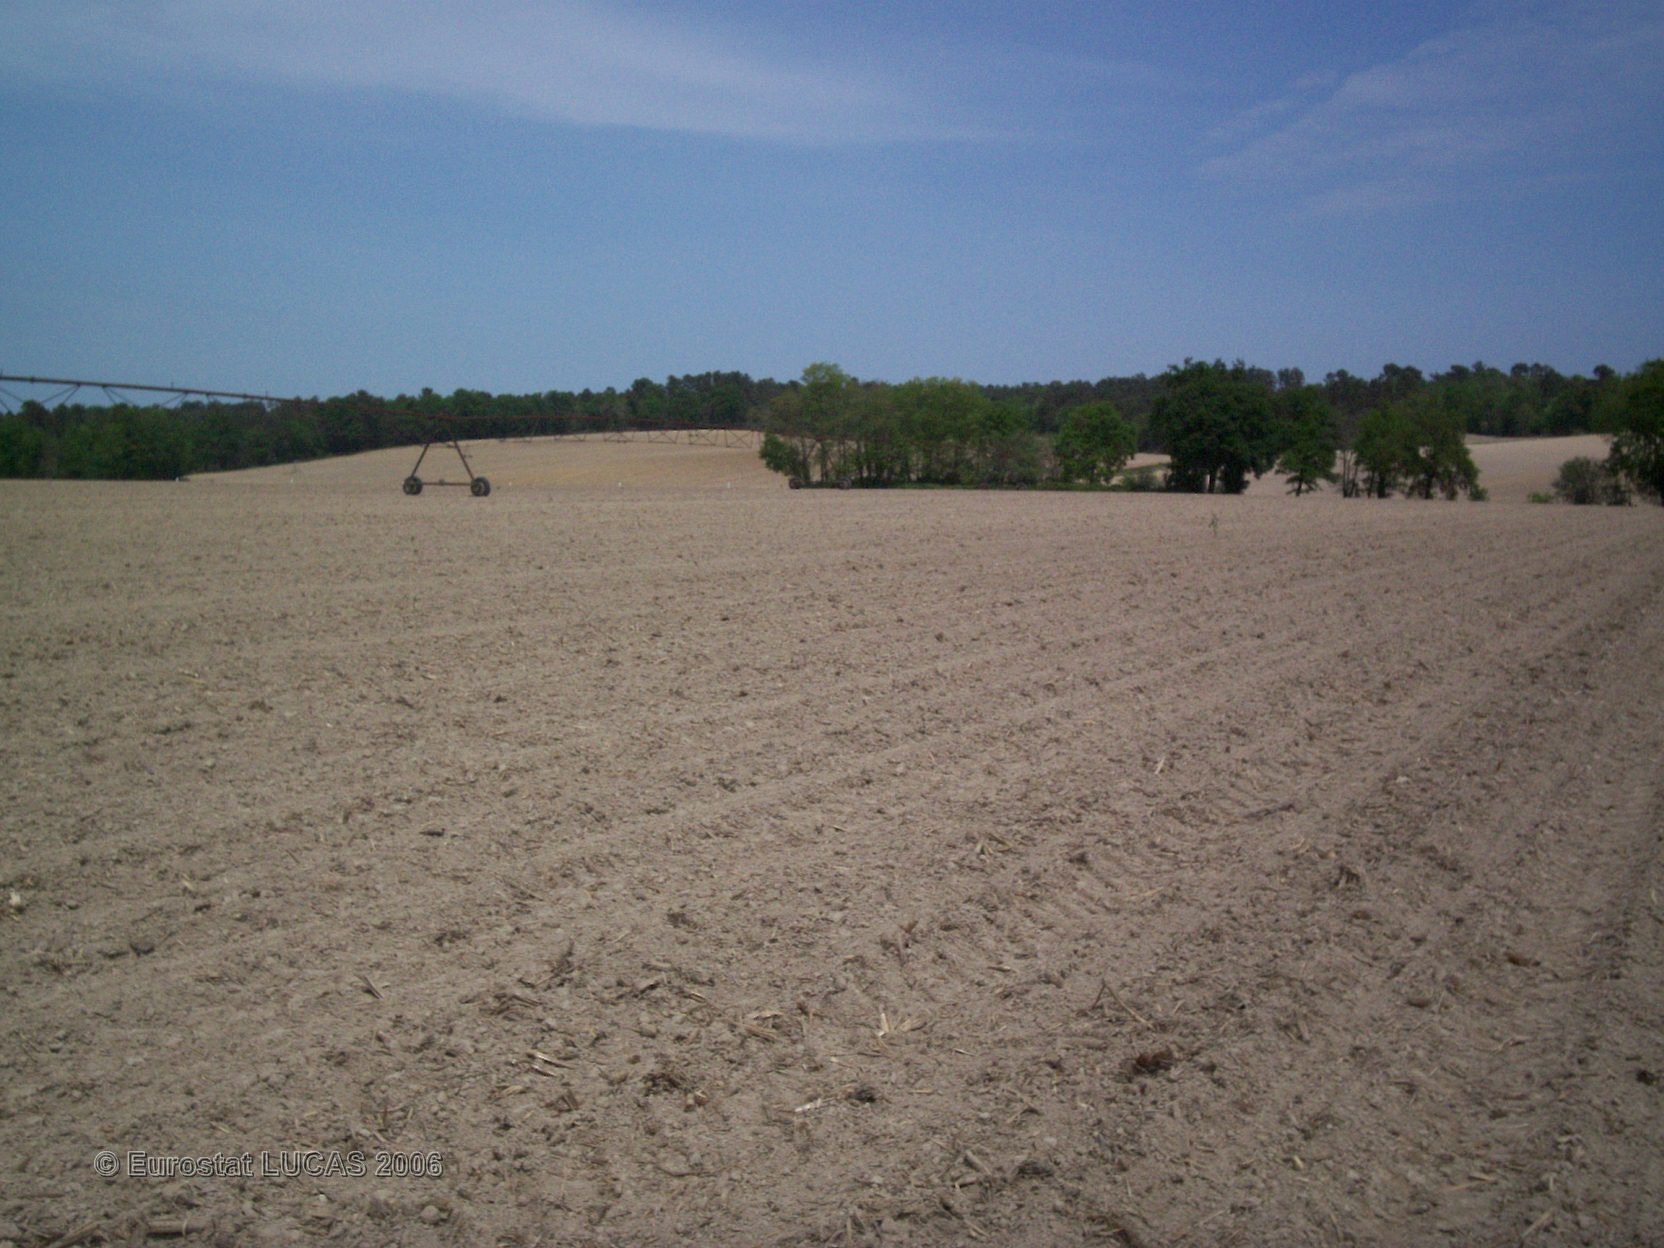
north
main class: Cropland
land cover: Maize
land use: Agriculture (excluding fallow land and kitchen gardens)
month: May
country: FR
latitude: 43.7861
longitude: -0.2609
